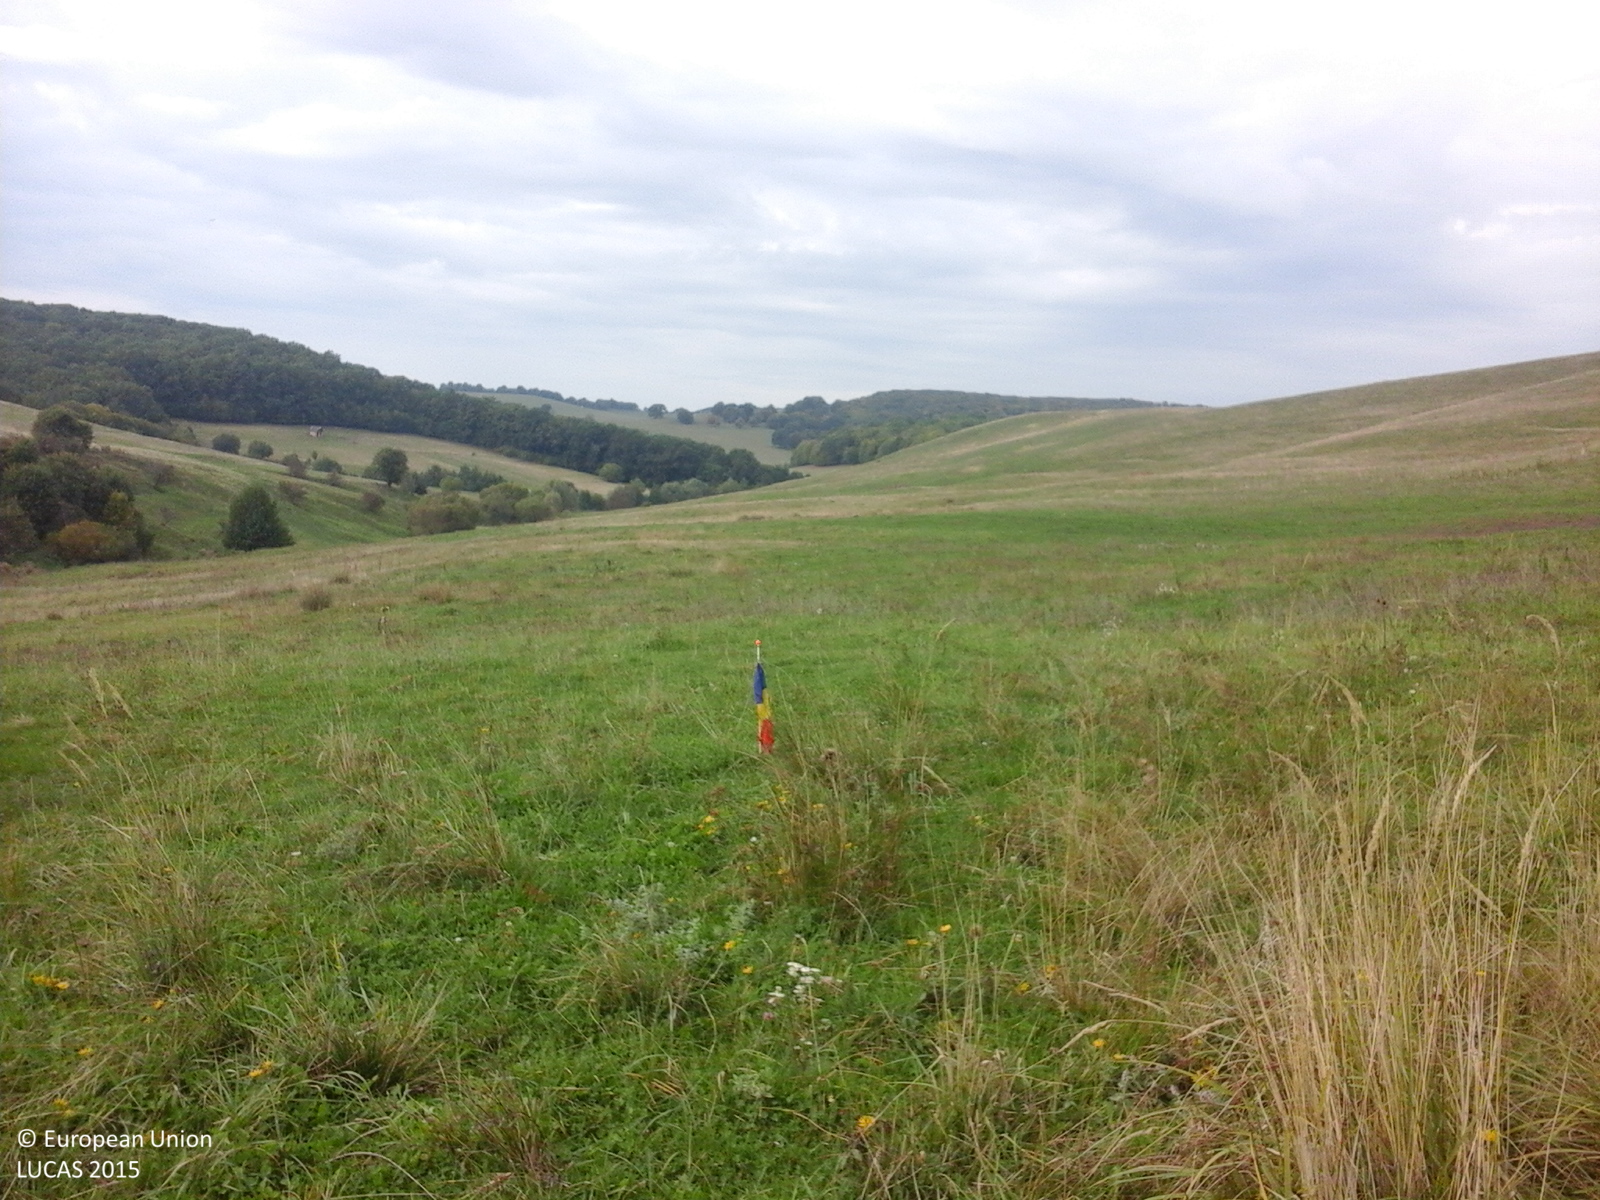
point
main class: Grassland
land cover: Grassland without tree/shrub cover
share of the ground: > 75 %
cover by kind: herbaceous plants 100 %
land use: Agriculture (excluding fallow land and kitchen gardens)
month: October
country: RO
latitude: 46.6581
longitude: 24.8759
